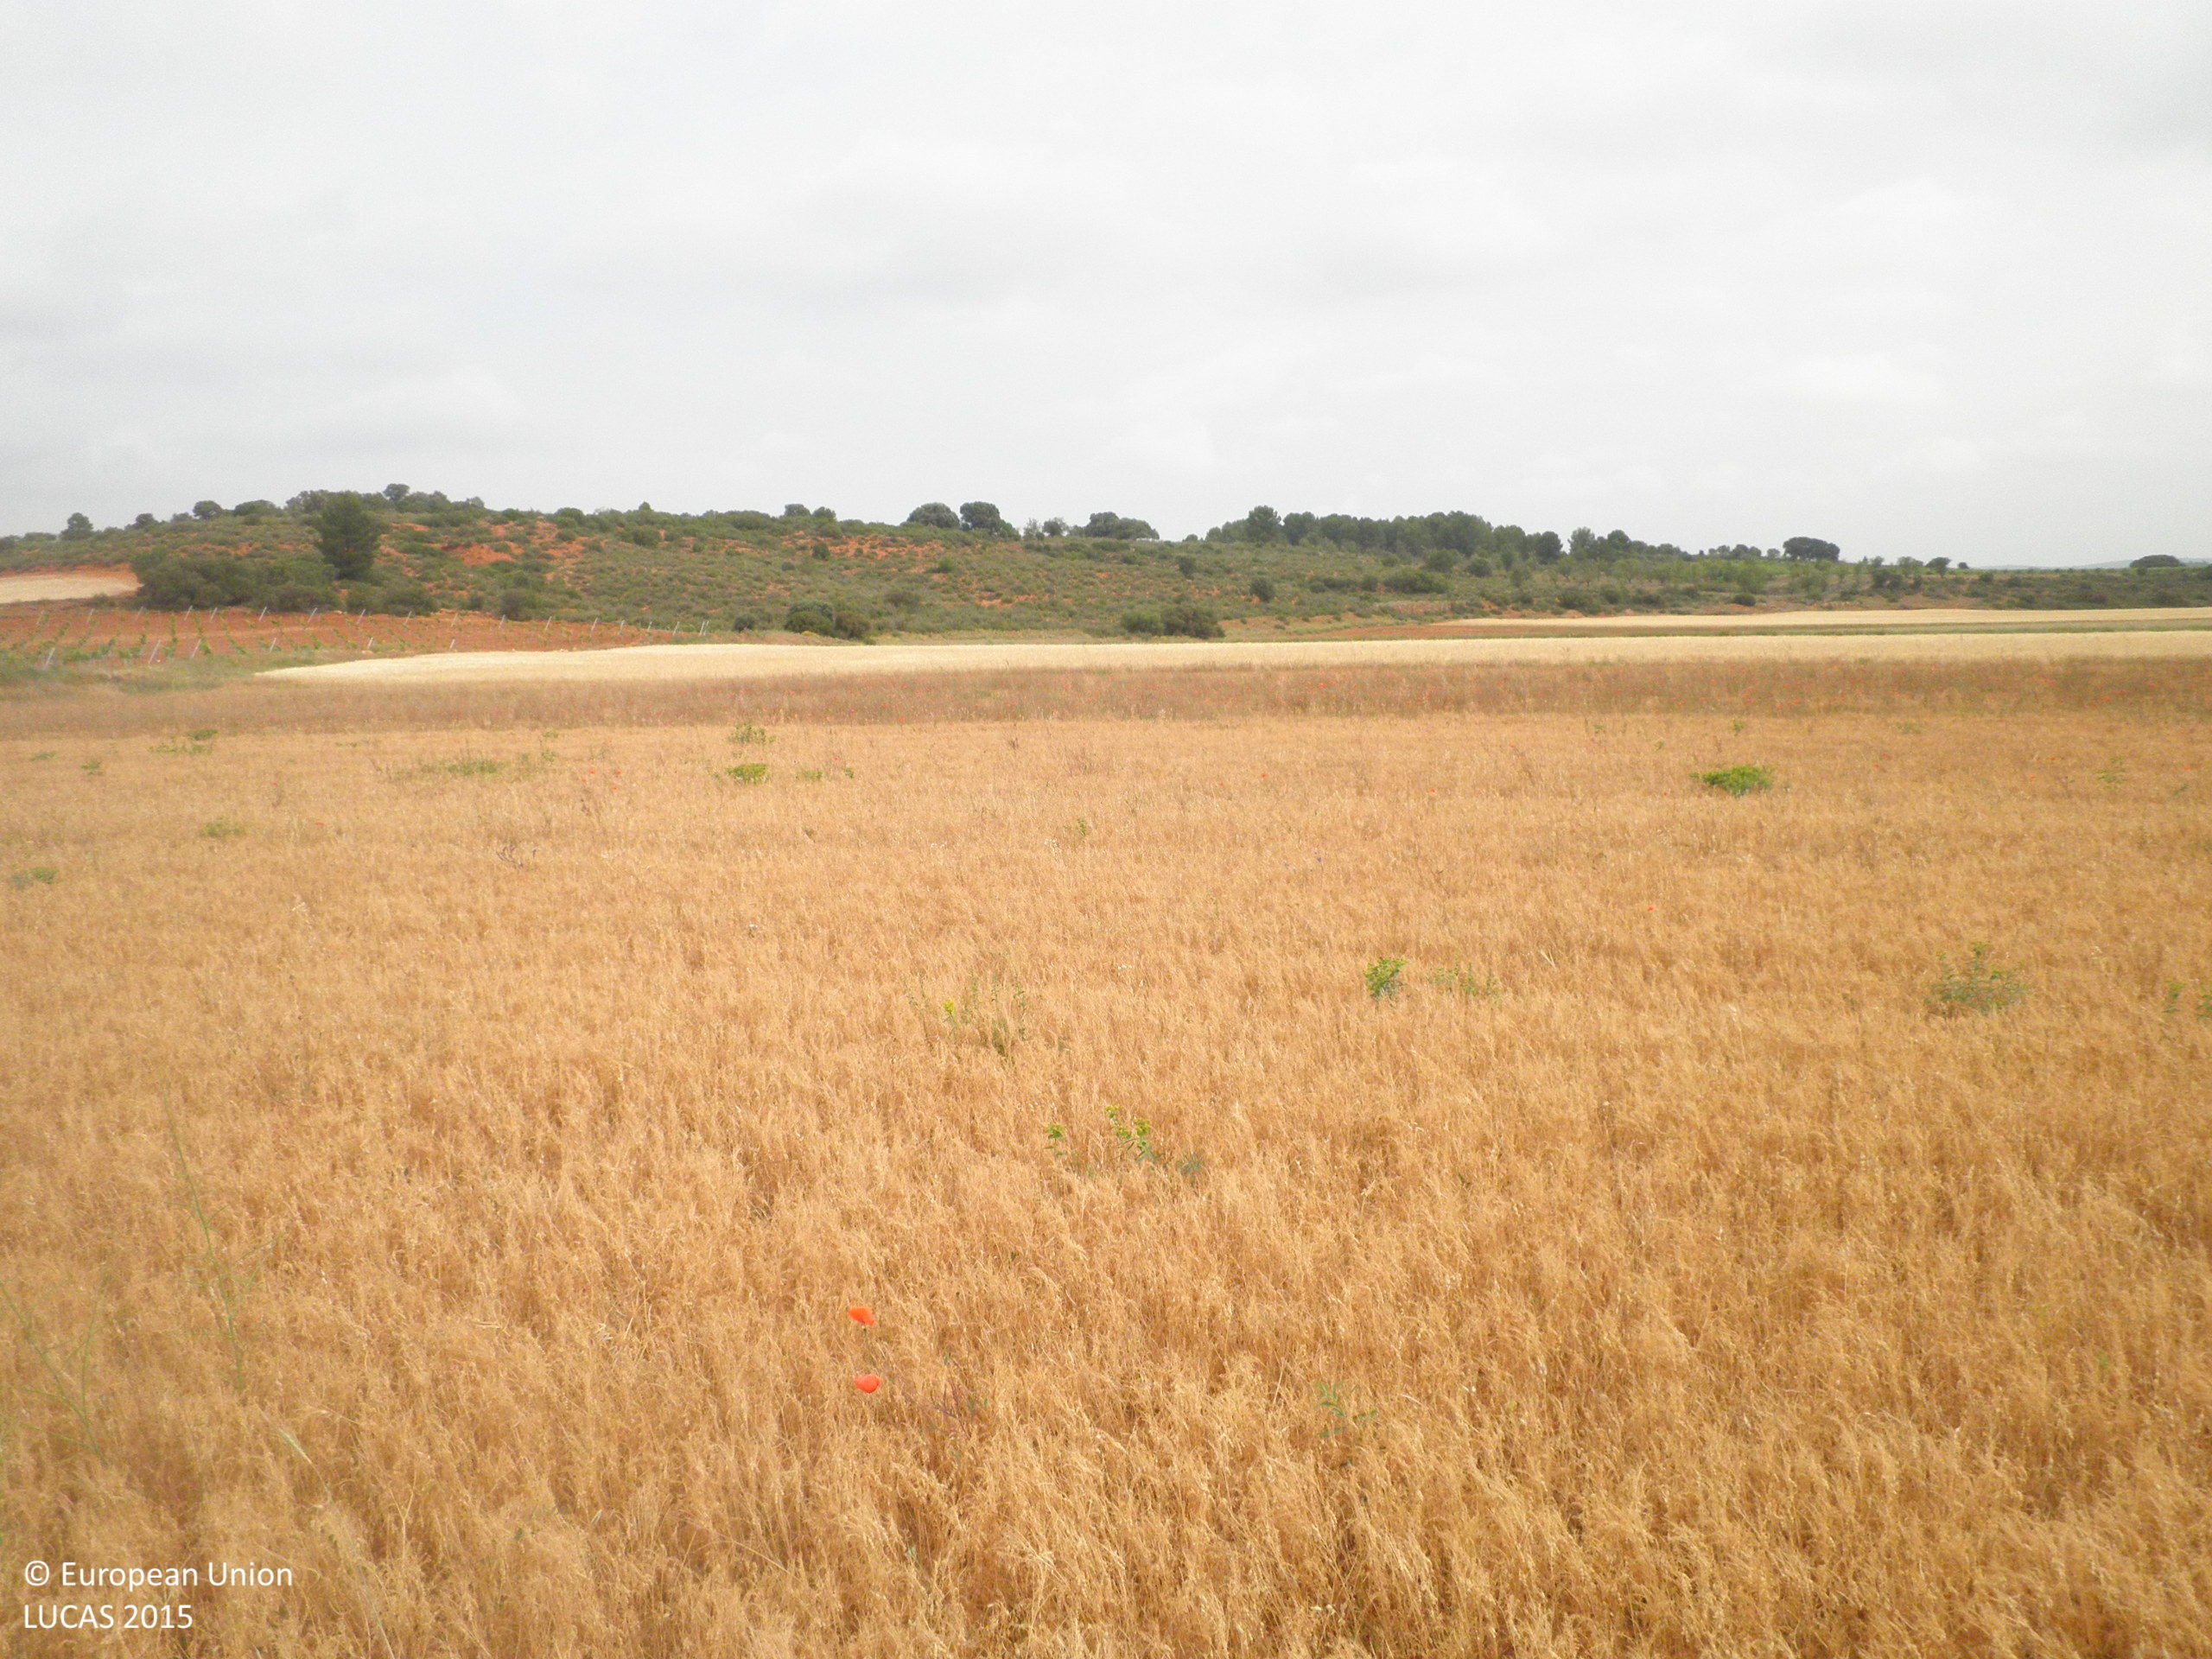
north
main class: Cropland
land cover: Dry pulses
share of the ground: > 75 %
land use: Agriculture (excluding fallow land and kitchen gardens)
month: June
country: ES
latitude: 39.5380
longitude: -1.7697
